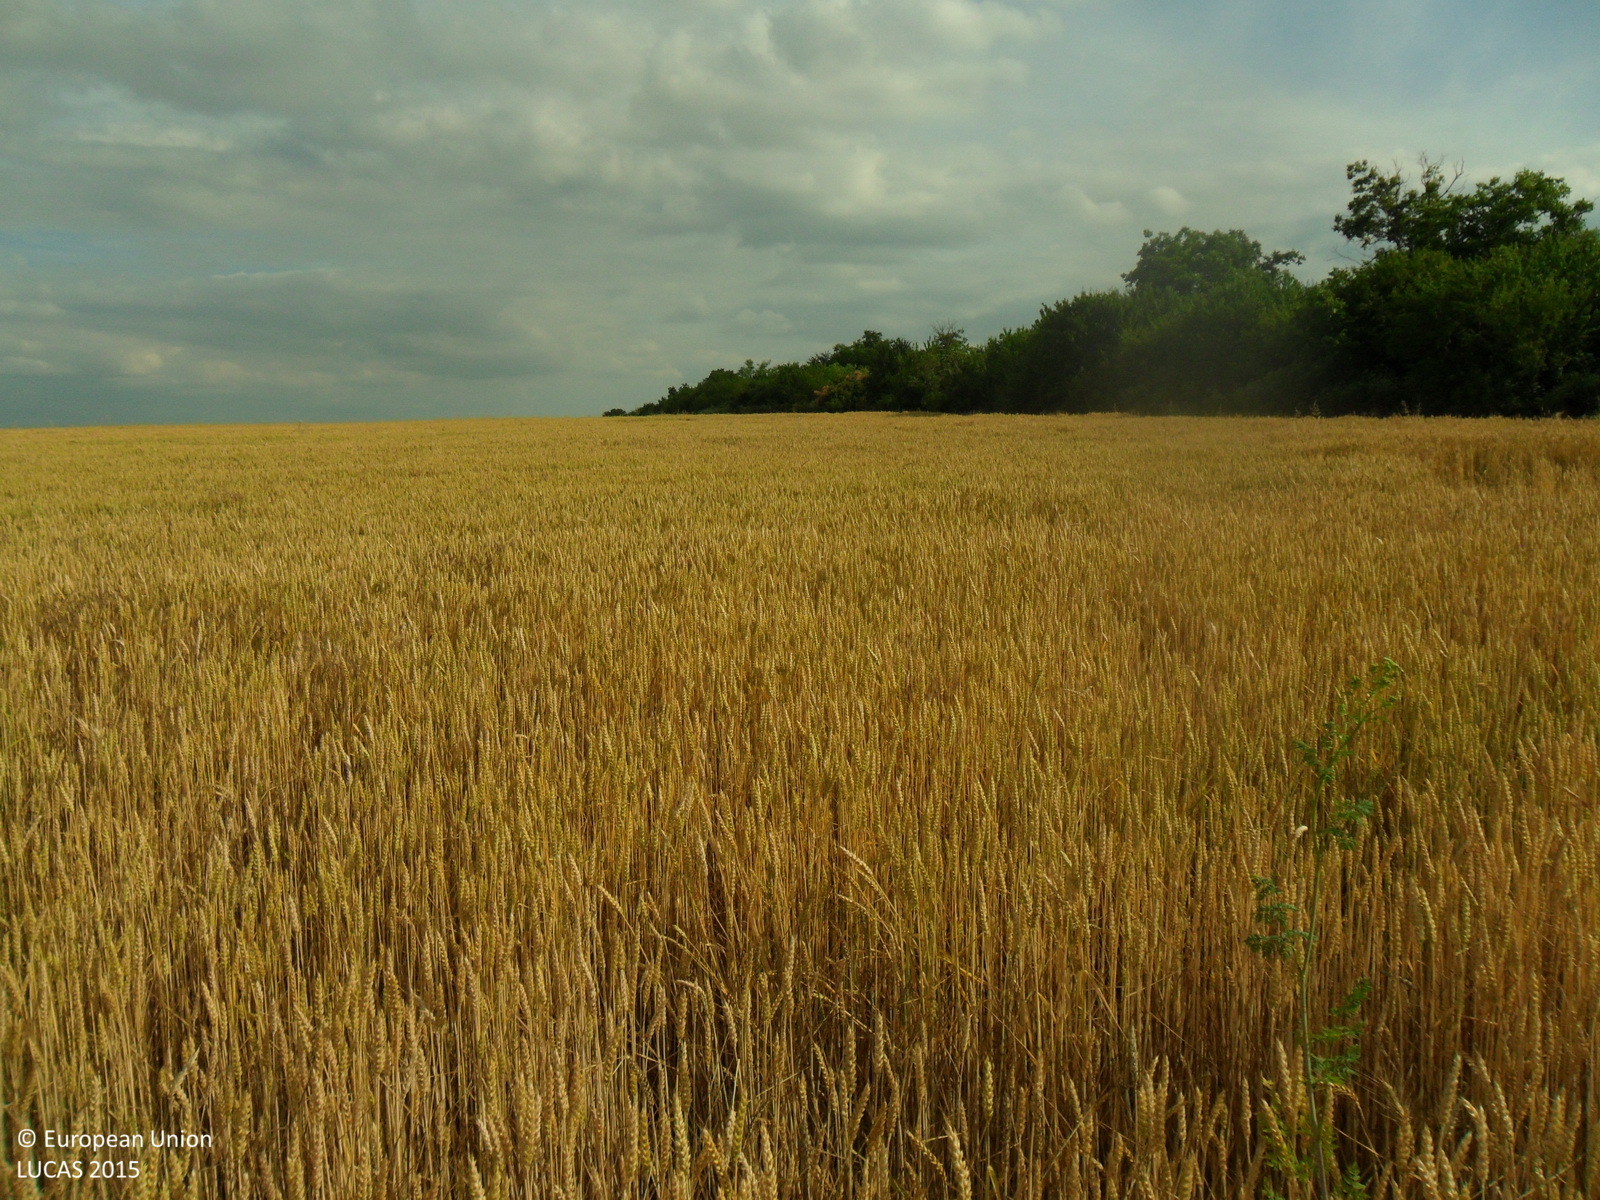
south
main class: Cropland
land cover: Common wheat
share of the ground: > 75 %
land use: Agriculture (excluding fallow land and kitchen gardens)
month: June
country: BG
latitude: 43.7914
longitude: 26.8313
